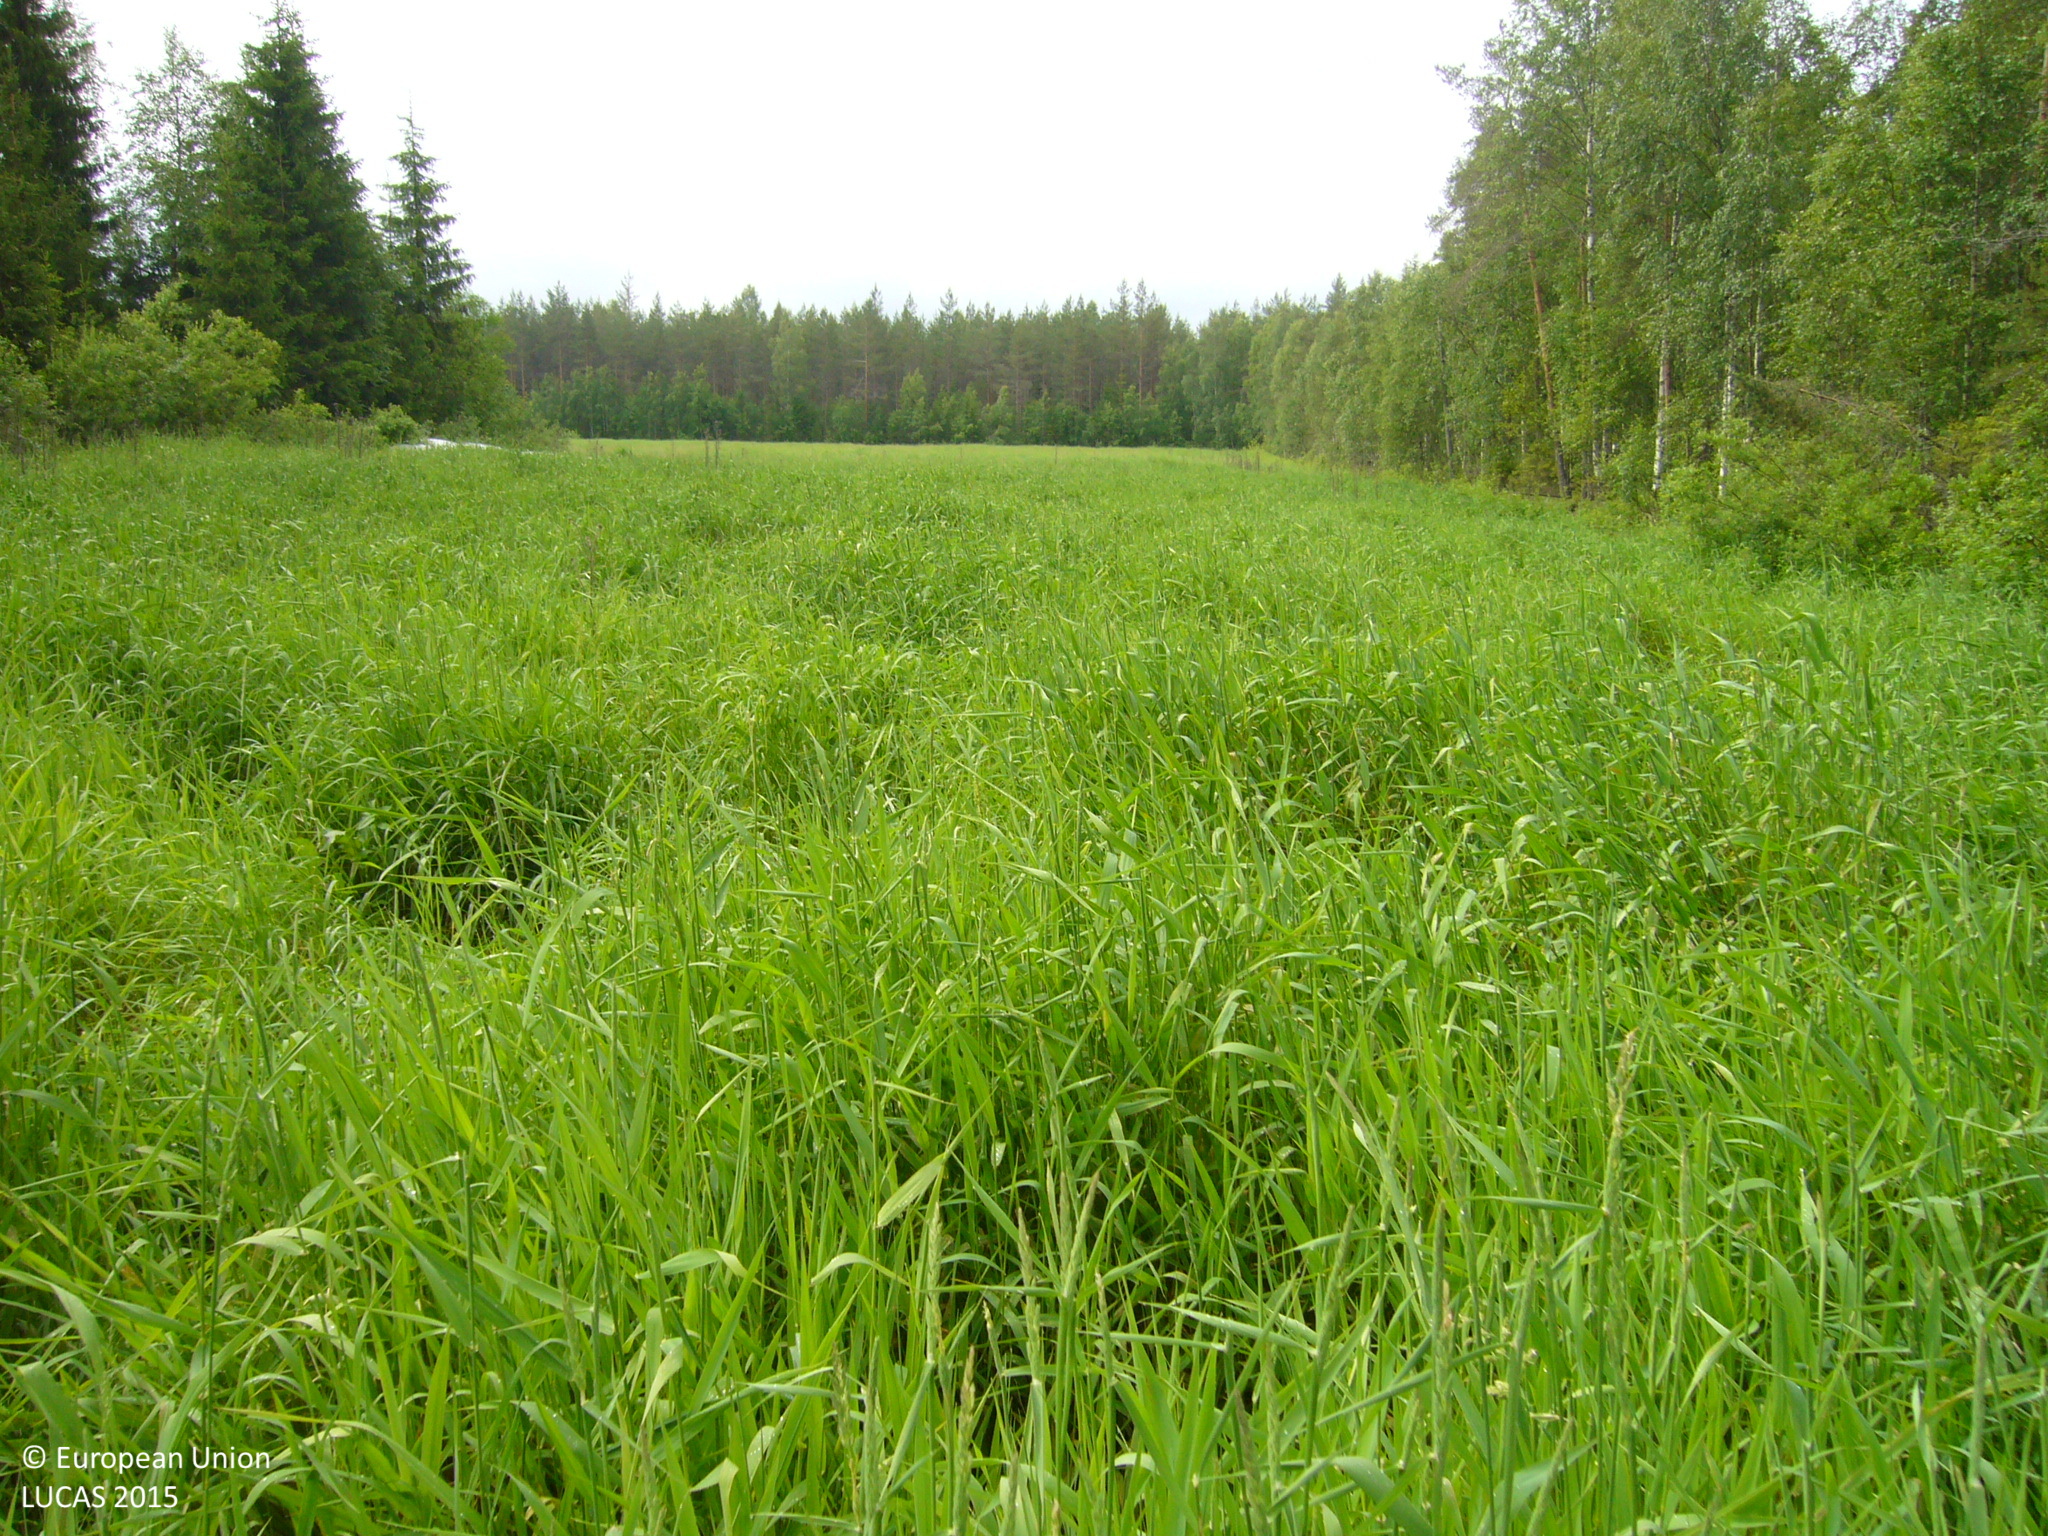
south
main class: Cropland
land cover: Temporary grasslands
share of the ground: > 75 %
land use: Agriculture (excluding fallow land and kitchen gardens)
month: July
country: FI
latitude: 63.5091
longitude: 25.5962
